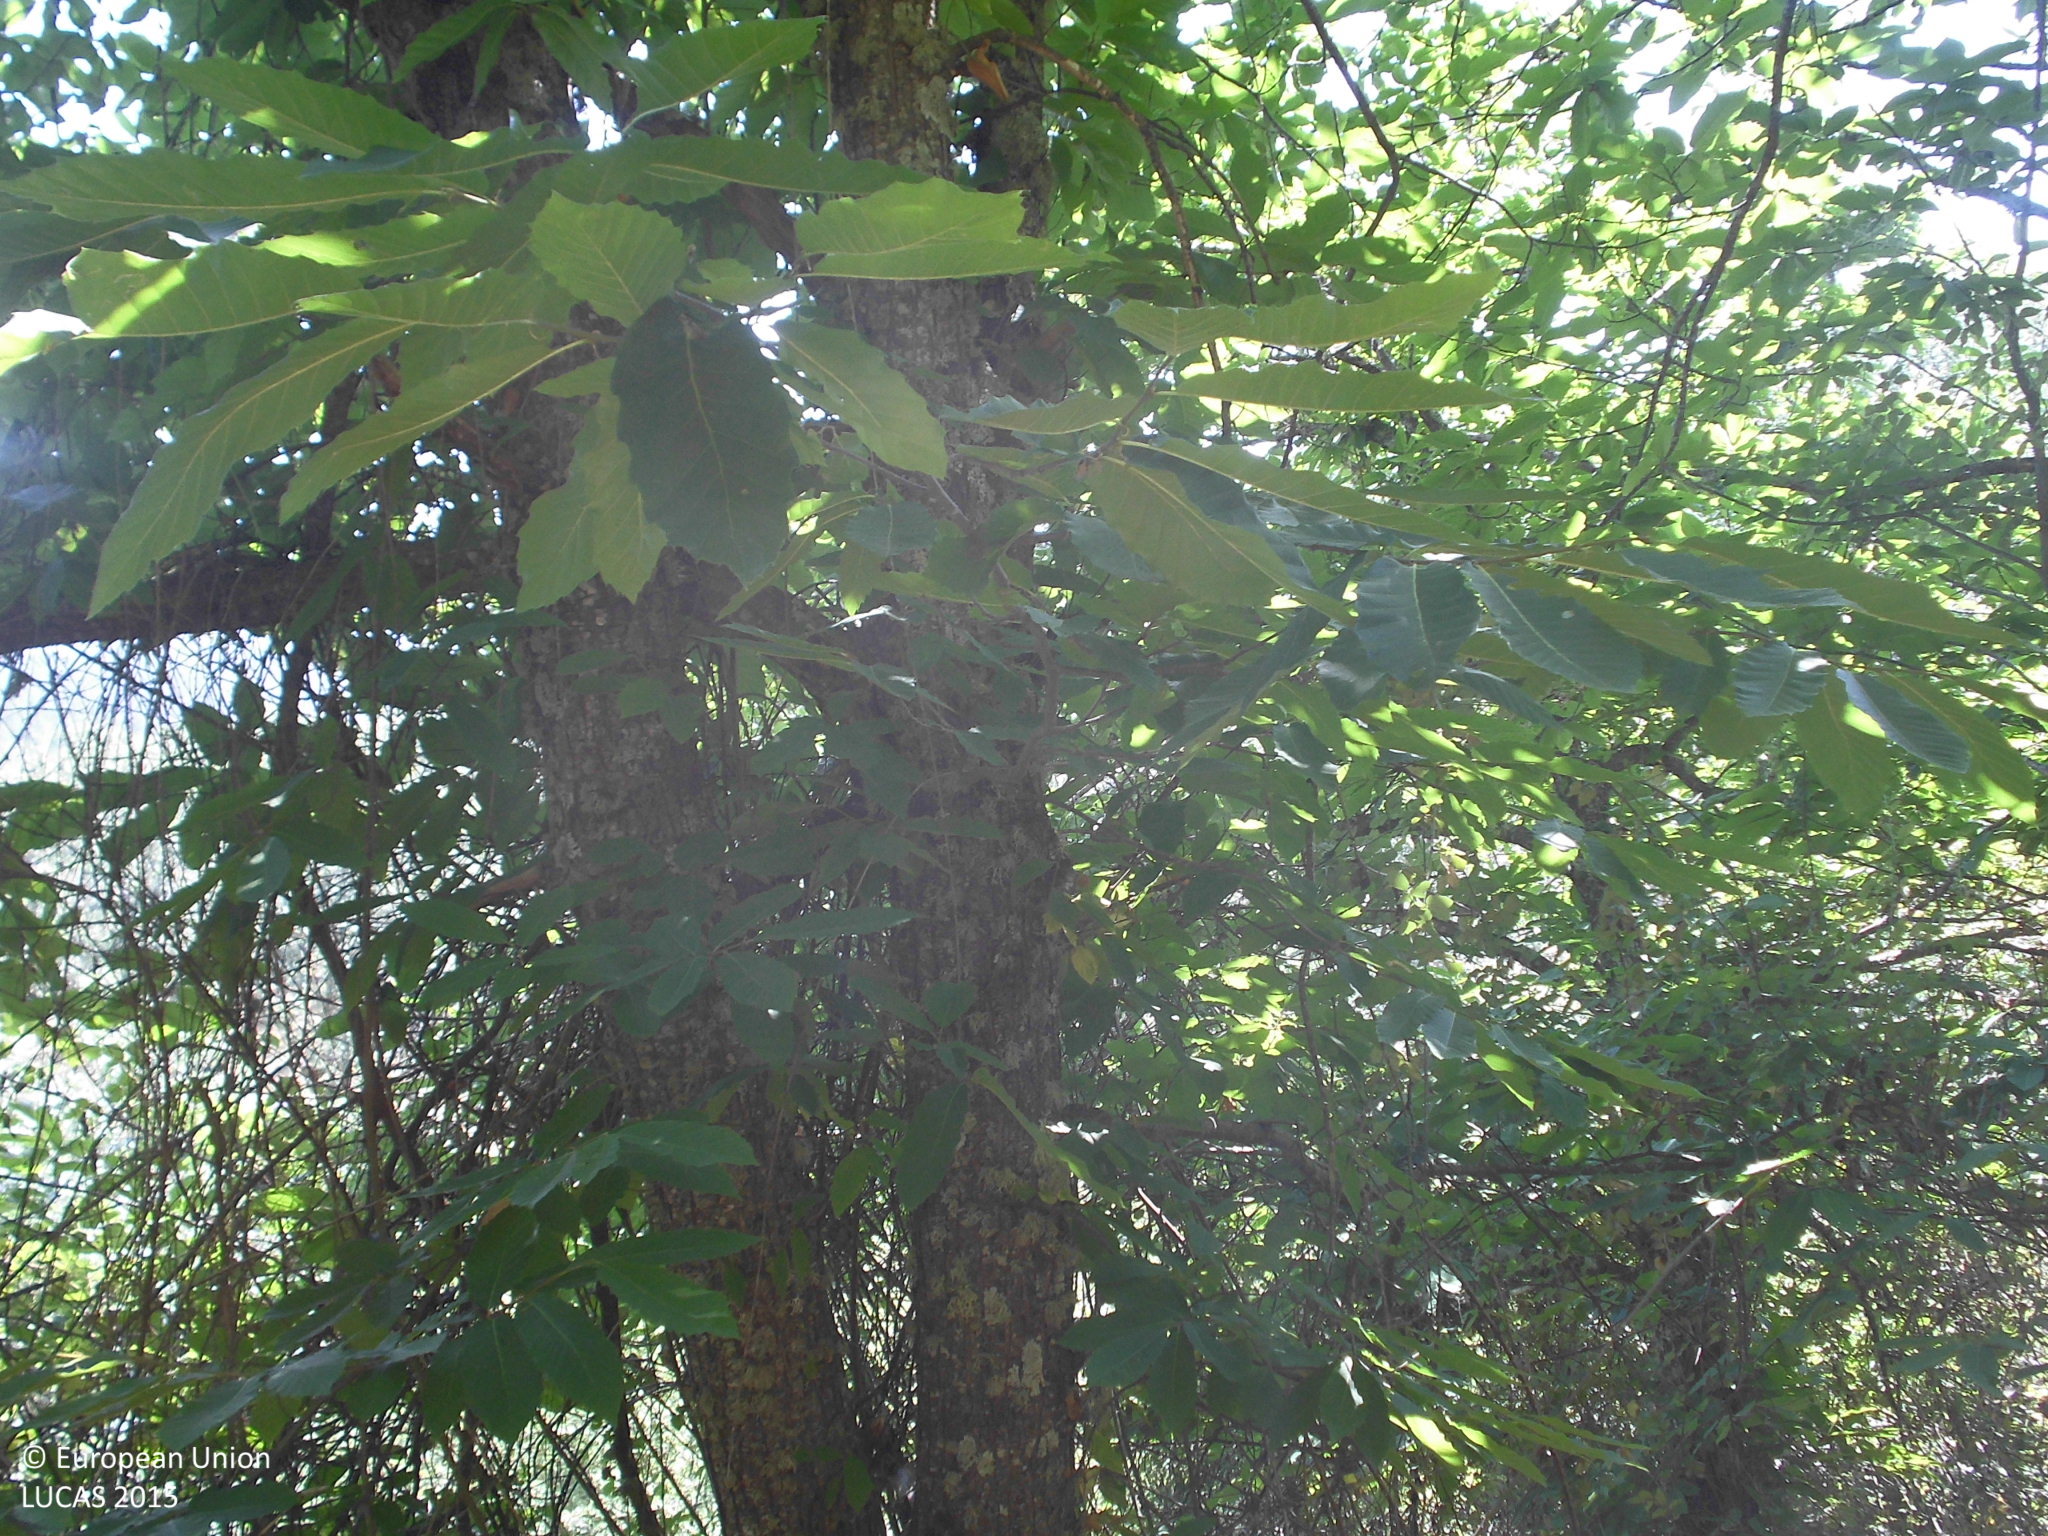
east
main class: Woodland
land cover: Broadleaved woodland
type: thermophilous deciduous forest
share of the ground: > 75 %
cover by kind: broadleaved forest trees 75 %, herbaceous plants 15 %, shrubs 10 %
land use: Forestry
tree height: > 5 m
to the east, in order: Broadleaved woodland
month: June
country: ES
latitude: 39.5258
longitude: -5.3711
